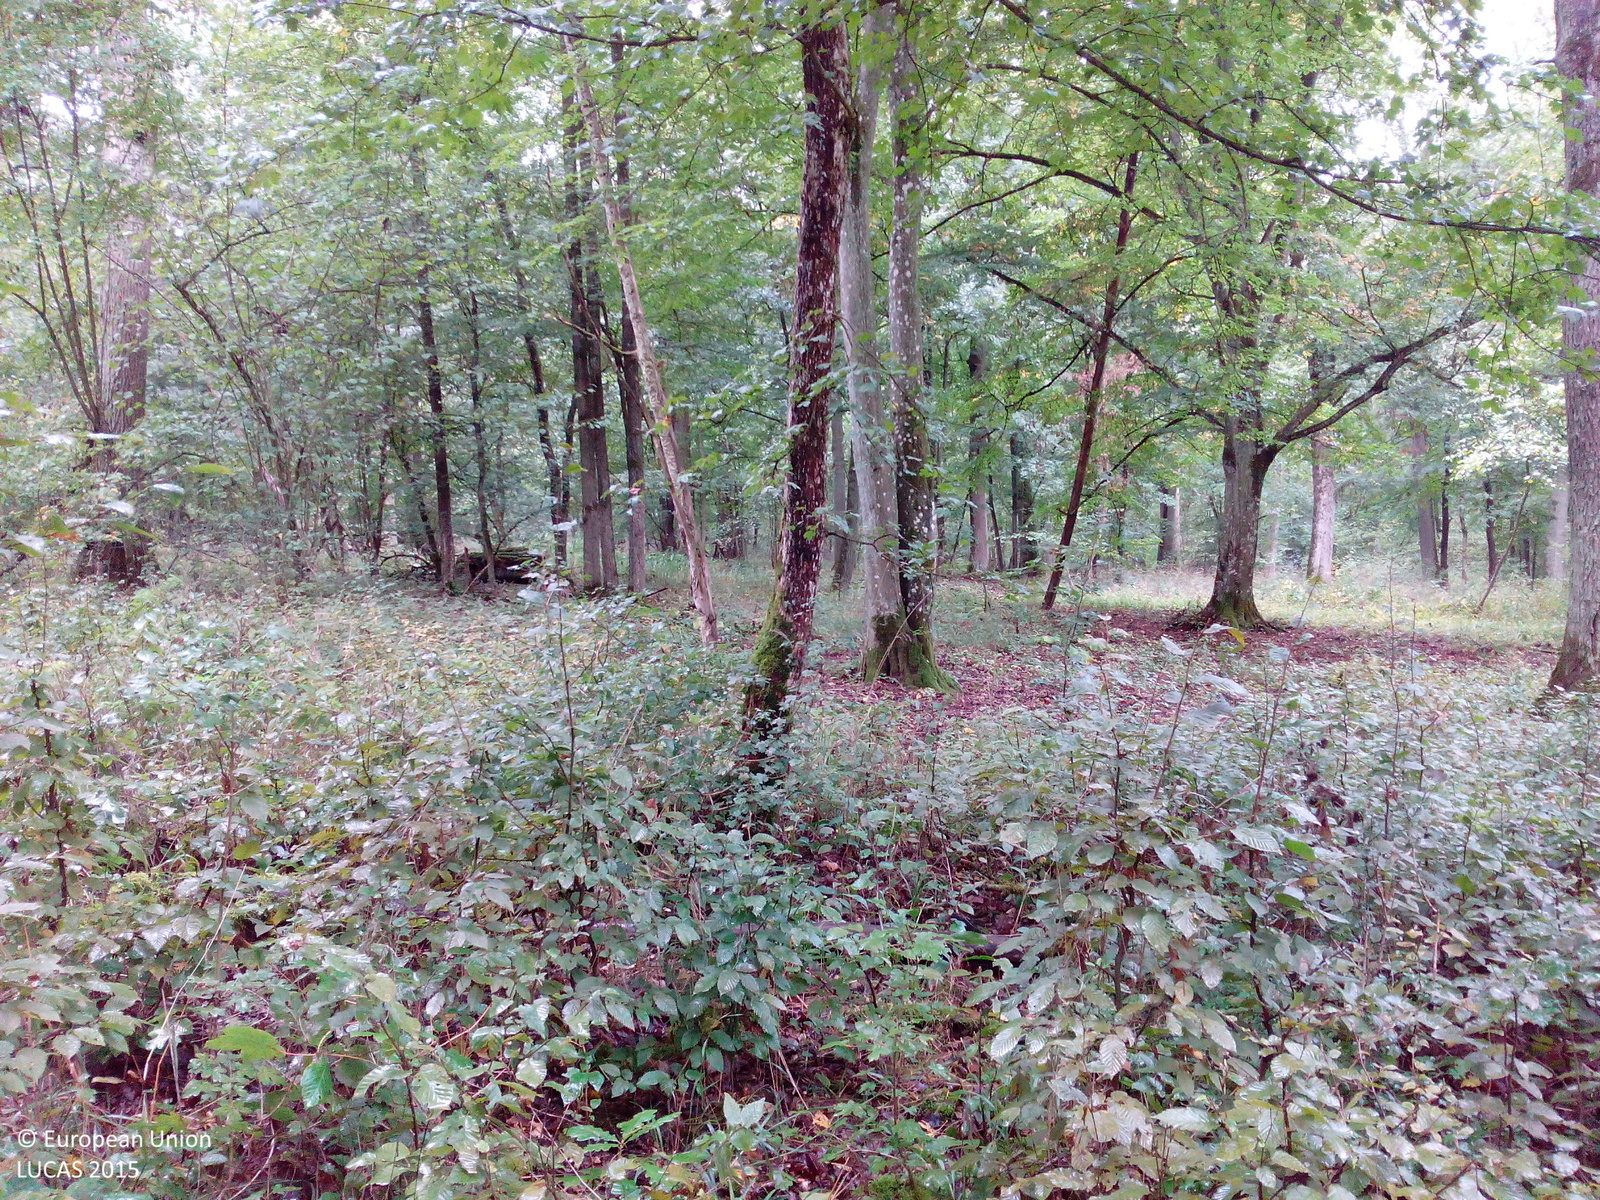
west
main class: Woodland
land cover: Broadleaved woodland
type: acidophilous oak and oak-birch forest
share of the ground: > 75 %
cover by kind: broadleaved forest trees 95 %, shrubs 5 %
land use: Forestry
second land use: Amenities, museums, leisure
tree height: > 5 m
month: September
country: DE
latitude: 49.9504
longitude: 9.9582
